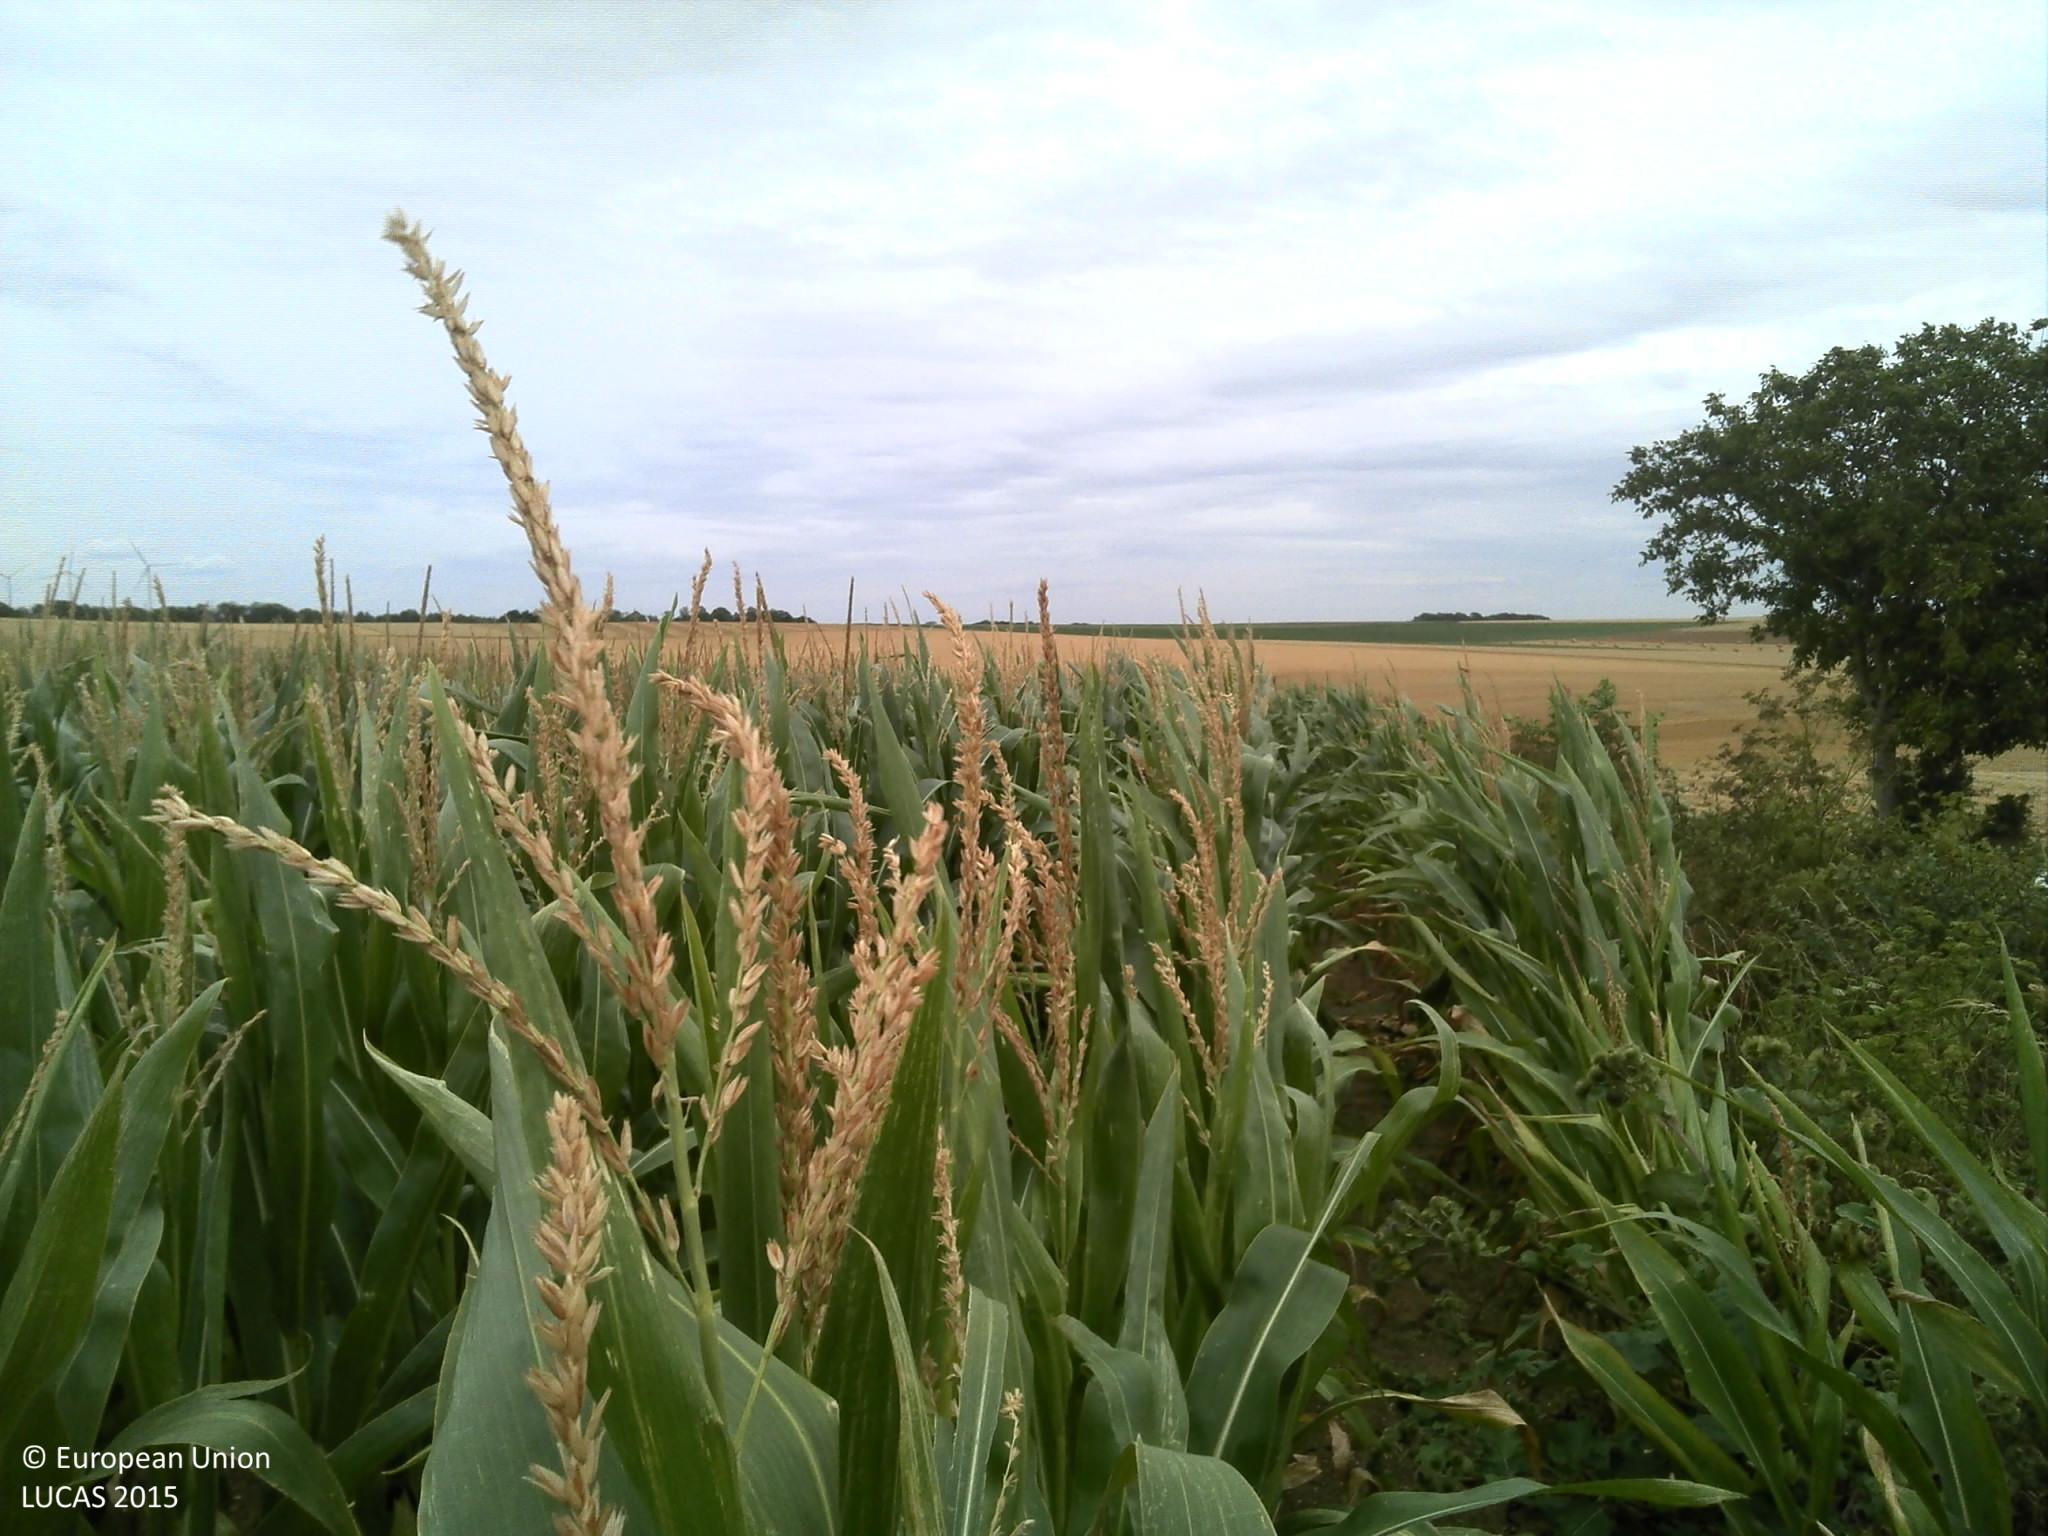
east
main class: Cropland
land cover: Maize
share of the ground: > 75 %
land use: Agriculture (excluding fallow land and kitchen gardens)
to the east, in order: Maize; Common wheat; Tracks; Common wheat
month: July
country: FR
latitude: 49.5085
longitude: 4.0980
